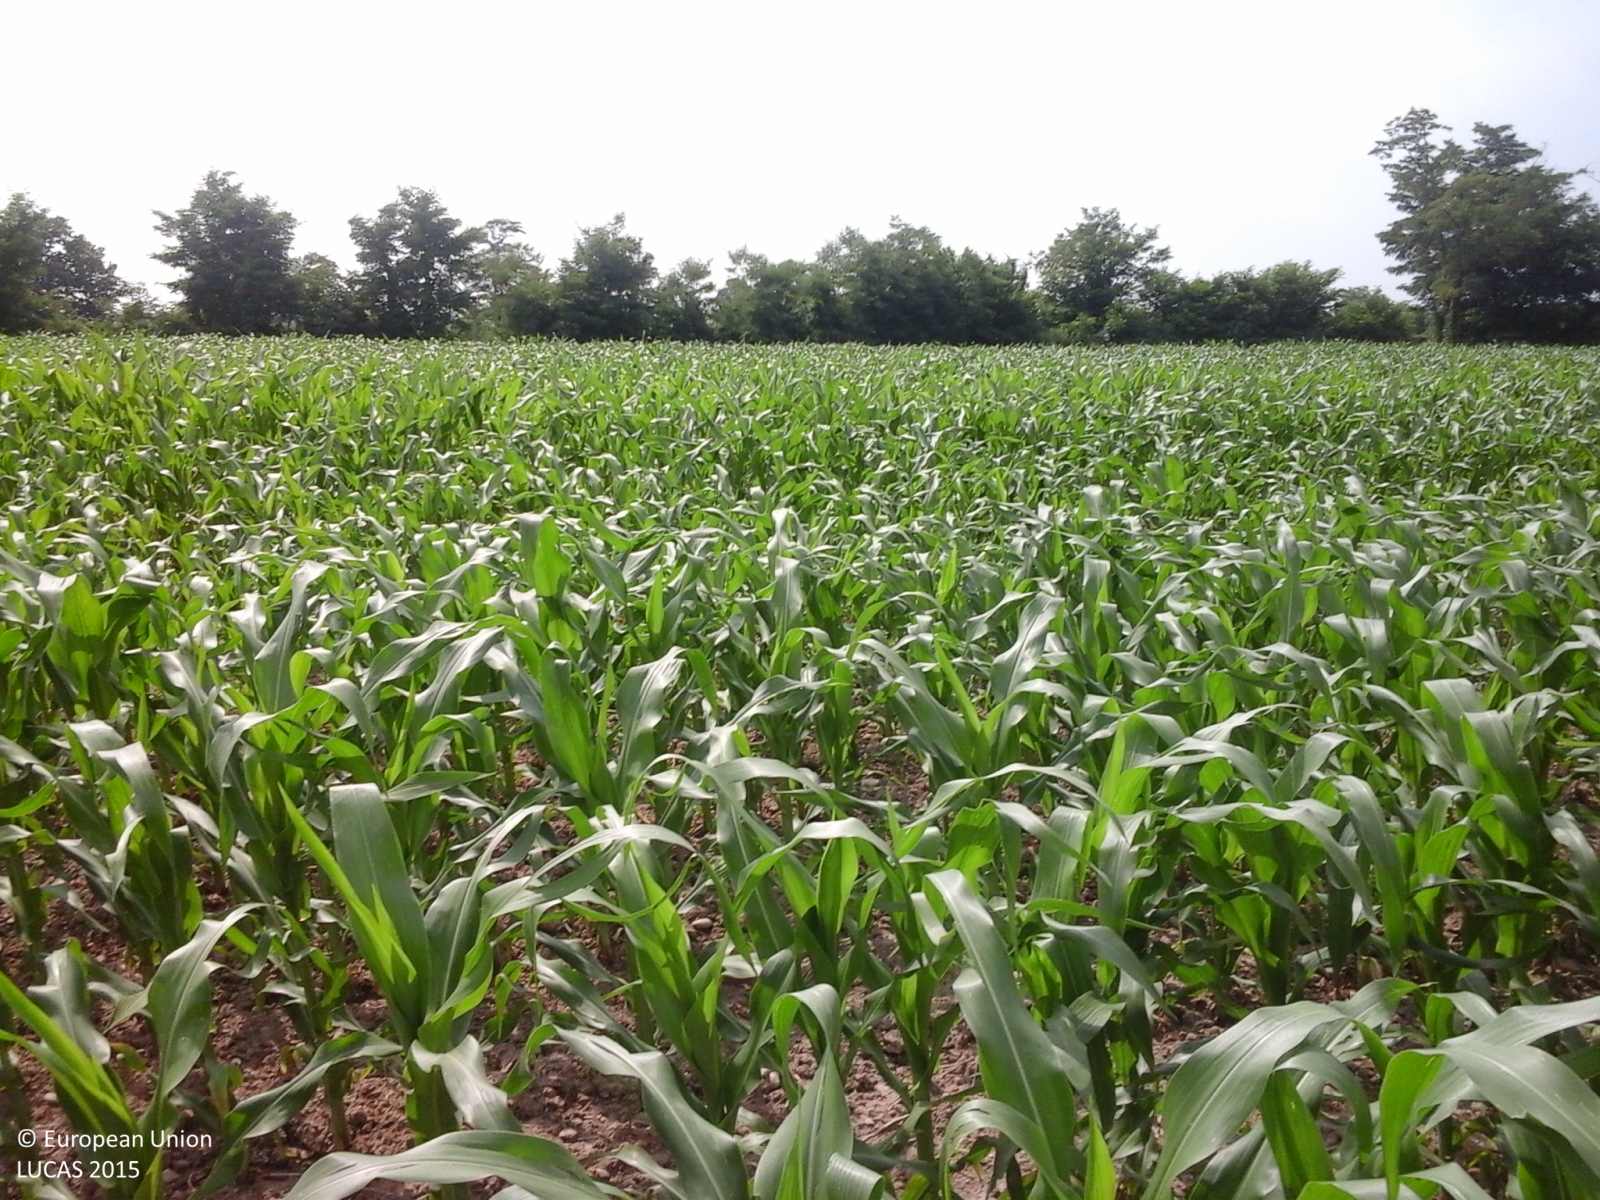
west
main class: Cropland
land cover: Maize
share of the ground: 50 - 75 %
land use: Agriculture (excluding fallow land and kitchen gardens)
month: June
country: IT
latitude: 45.3884
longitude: 8.7122
